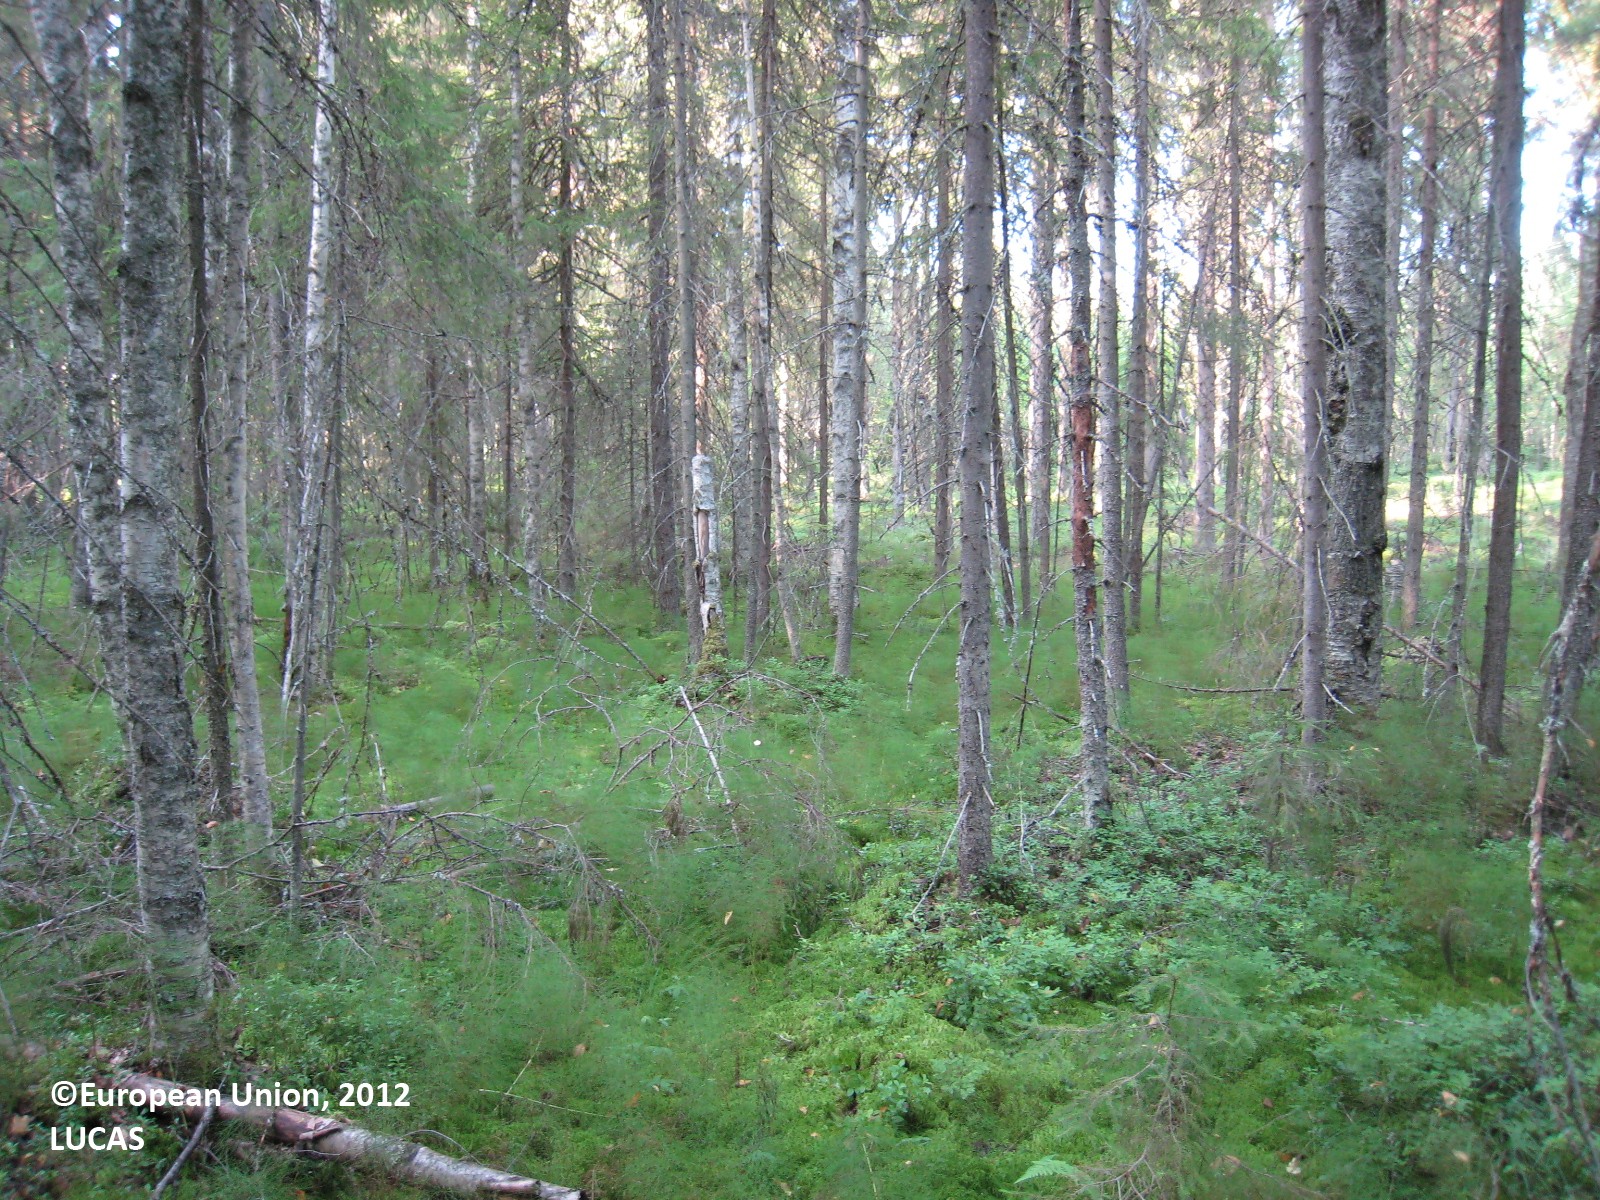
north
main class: Woodland
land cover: Spruce dominated mixed woodland
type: mire and swamp forests
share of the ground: > 75 %
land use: Forestry
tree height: > 5 m
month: July
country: FI
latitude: 62.5892
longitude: 27.3946
